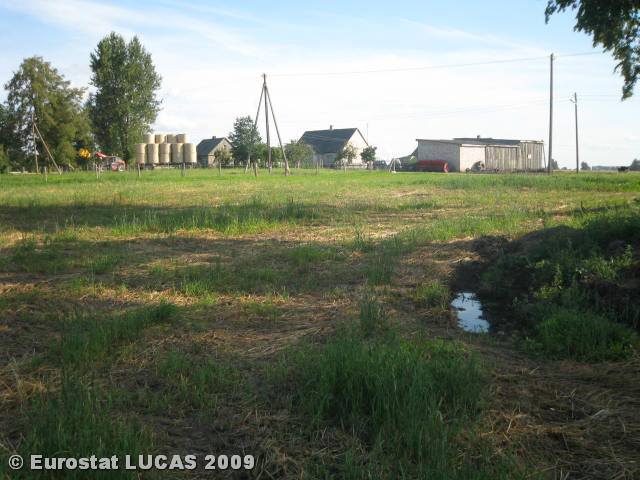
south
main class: Grassland
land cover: Grassland without tree/shrub cover
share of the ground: 25 - 50 %
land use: Fallow land
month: August
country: LT
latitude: 55.3079
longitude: 23.6468
